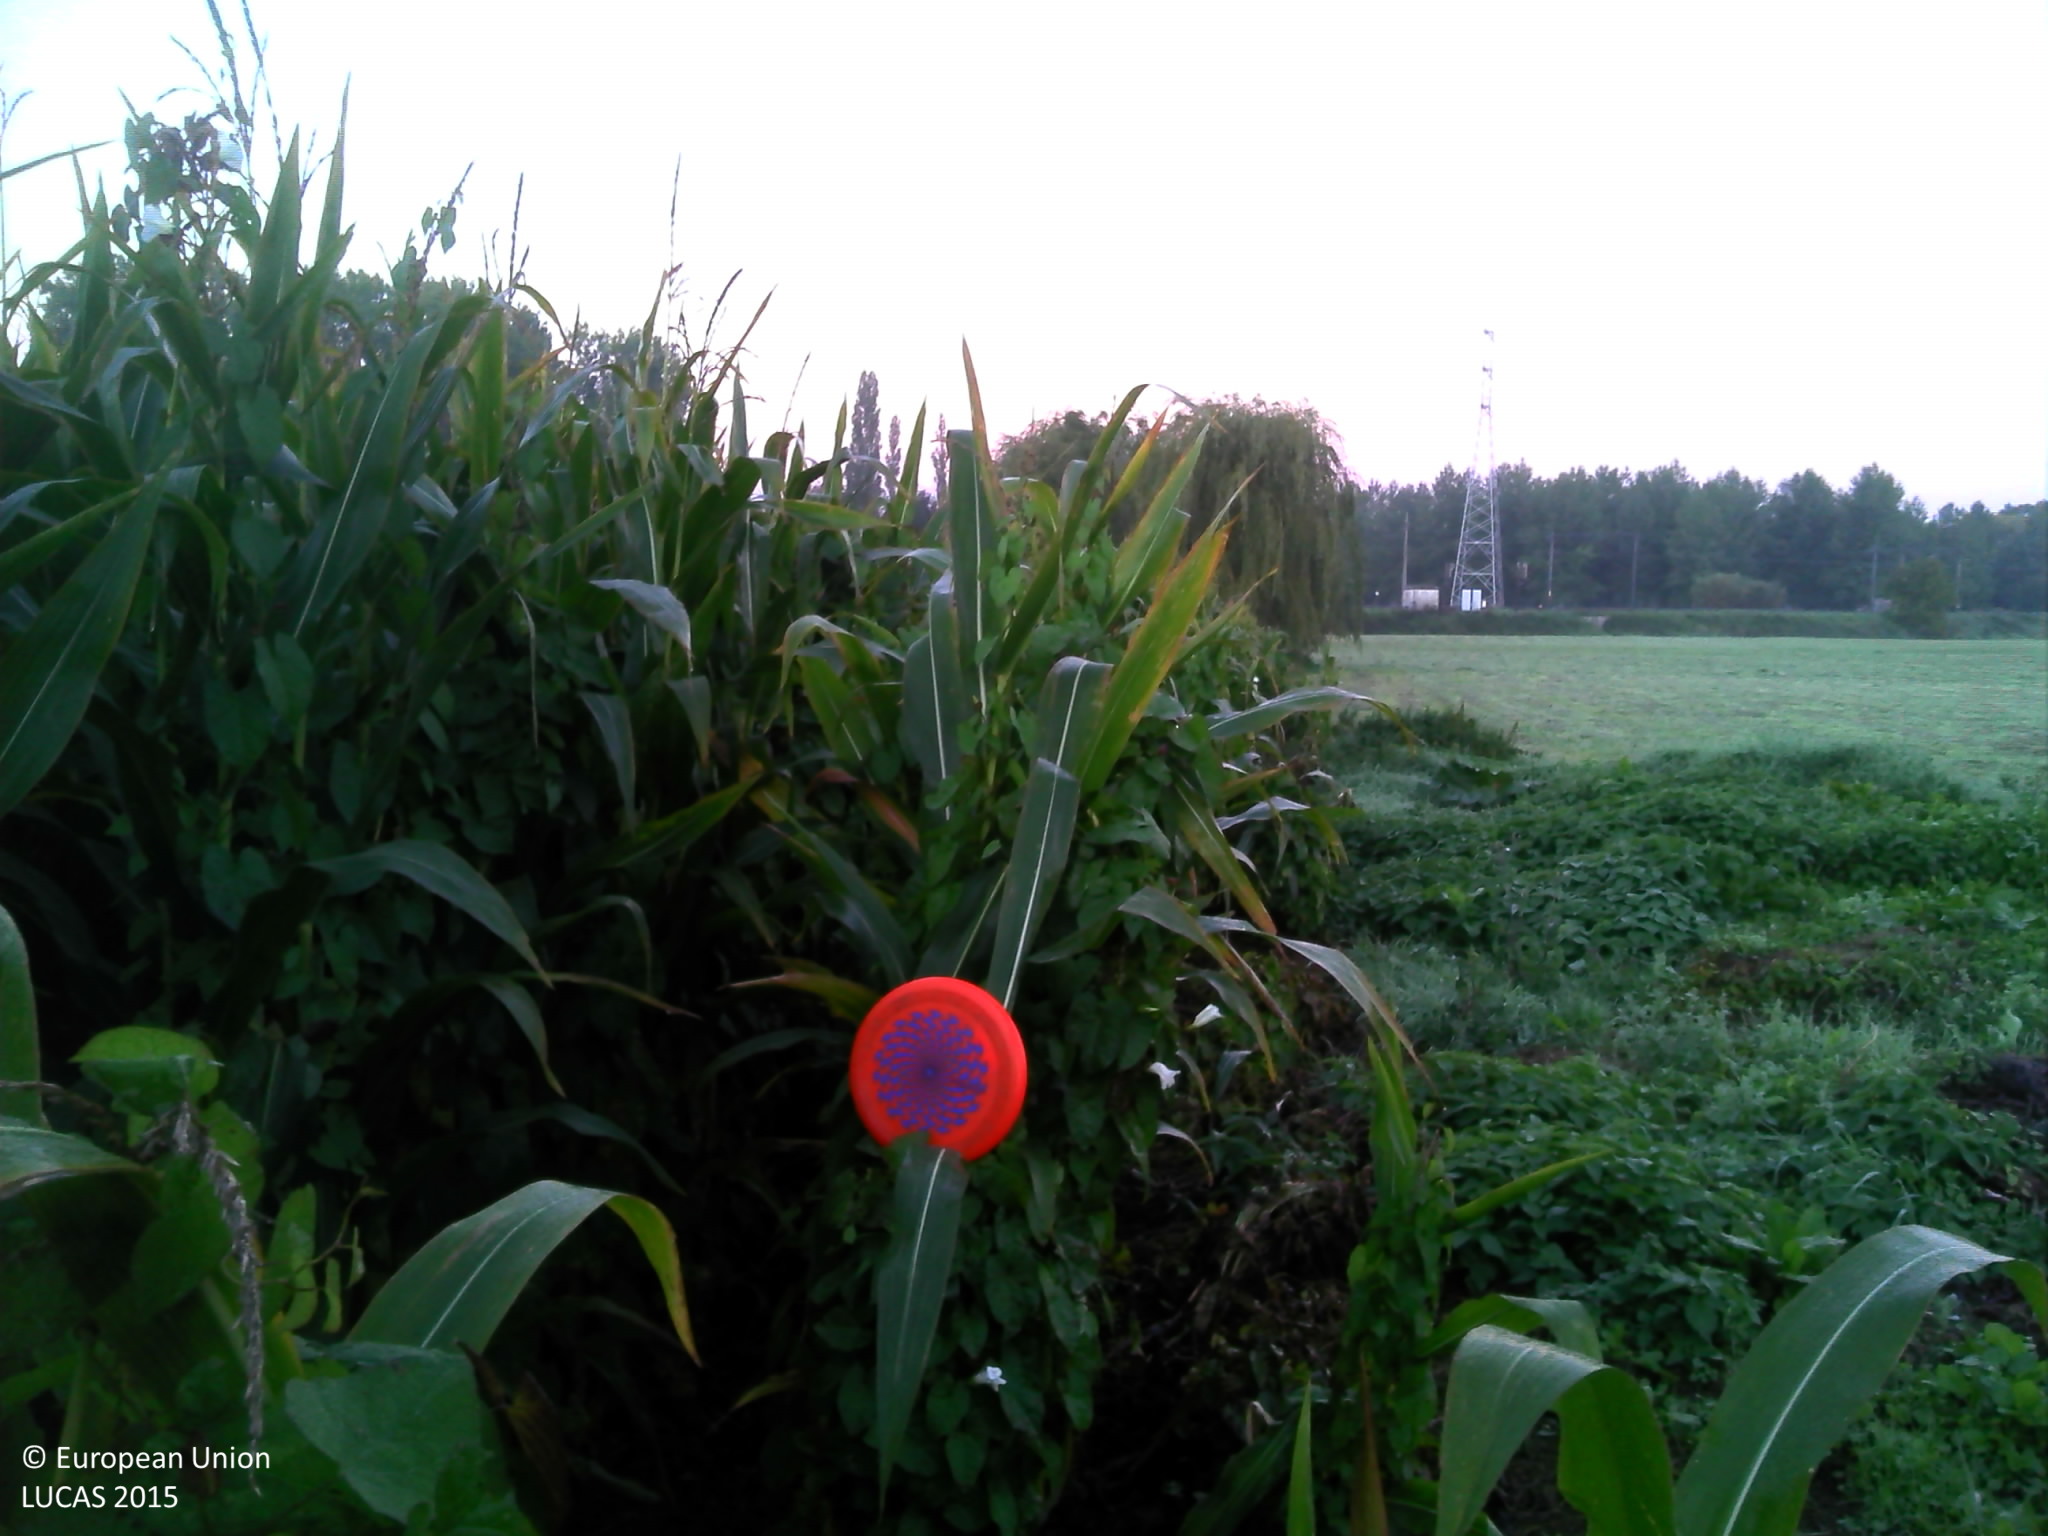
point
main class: Grassland
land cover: Spontaneously vegetated surfaces
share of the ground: > 75 %
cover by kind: herbaceous plants 80 %, unconsolidated bare surface 20 %
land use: Residential
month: September
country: BE
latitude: 51.1519
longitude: 4.5202
